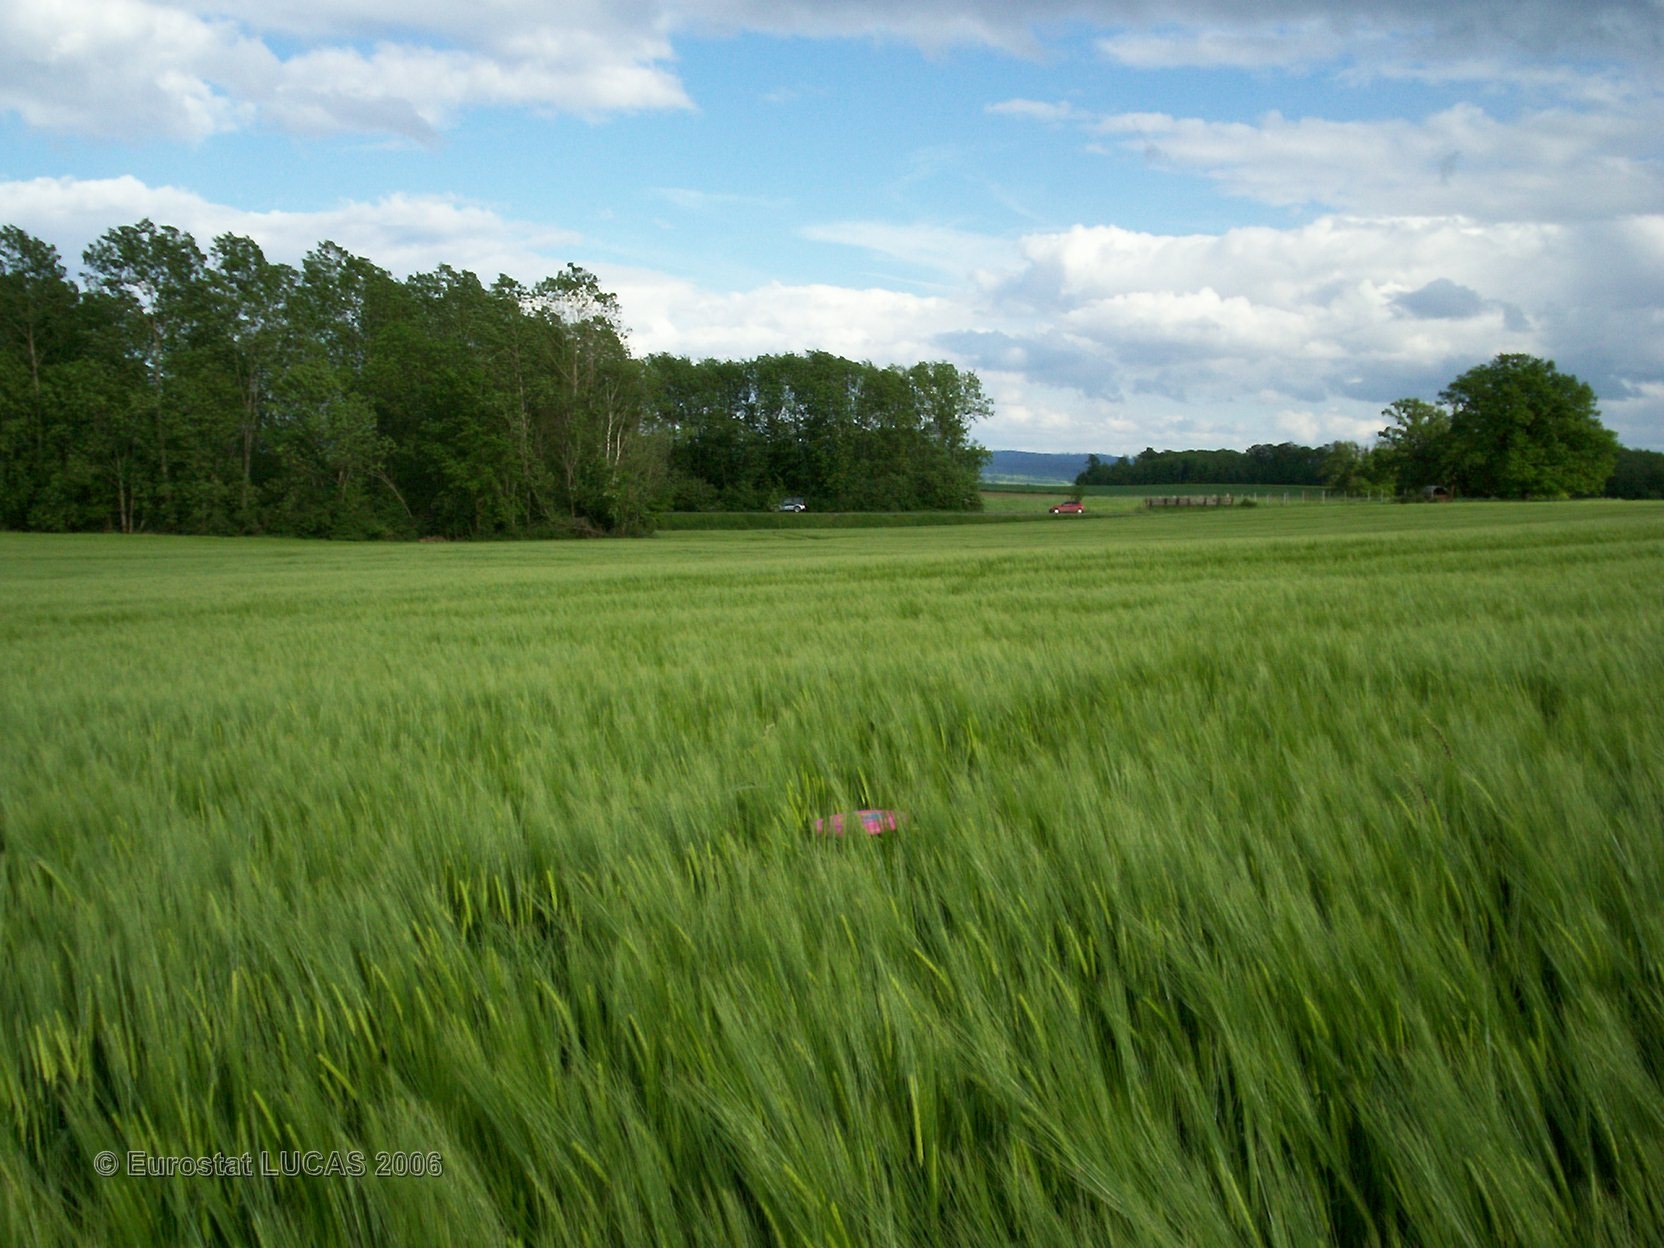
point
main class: Cropland
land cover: Barley
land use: Agriculture (excluding fallow land and kitchen gardens)
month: May
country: FR
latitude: 48.5011
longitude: 6.7931
